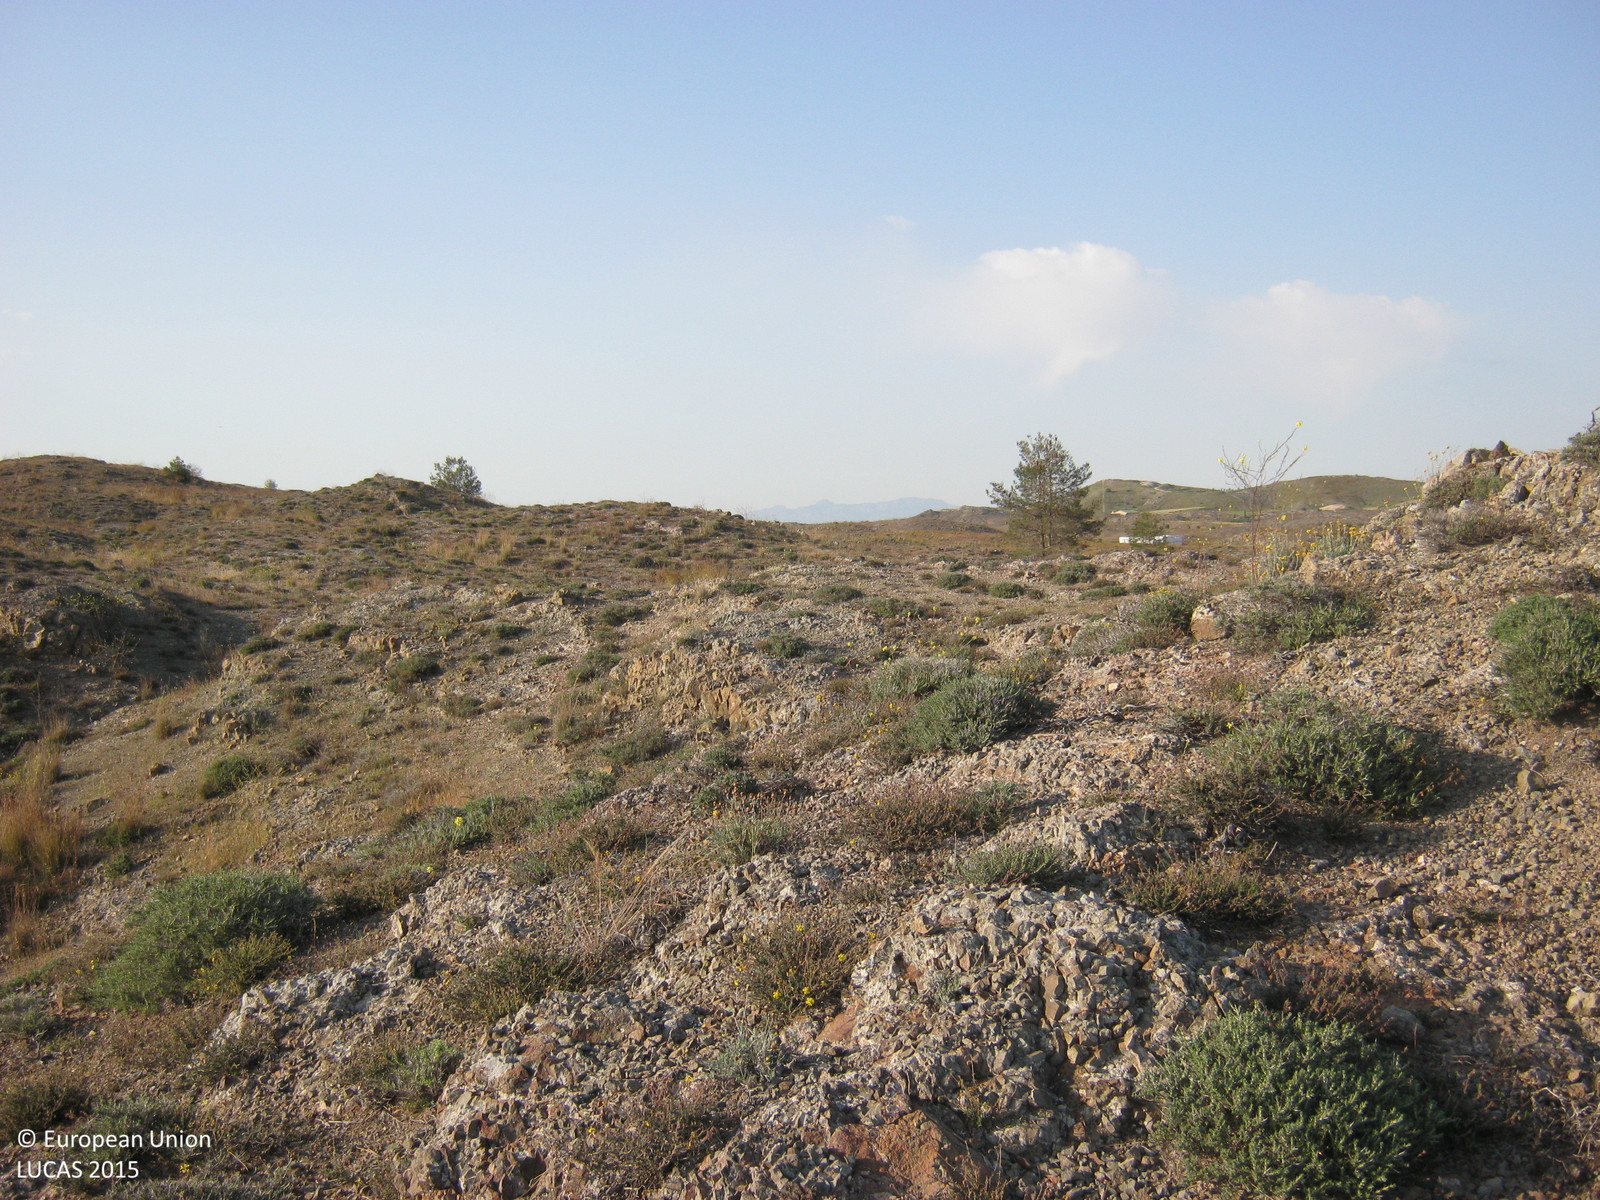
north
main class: Shrubland
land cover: Shrubland without tree cover
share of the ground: 25 - 50 %
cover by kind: unconsolidated bare surface 30 %, shrubs 25 %, herbaceous plants 25 %, consolidated bare surface 20 %
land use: Semi-natural and natural areas not in use
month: April
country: CY
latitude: 34.9781
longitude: 33.3775
